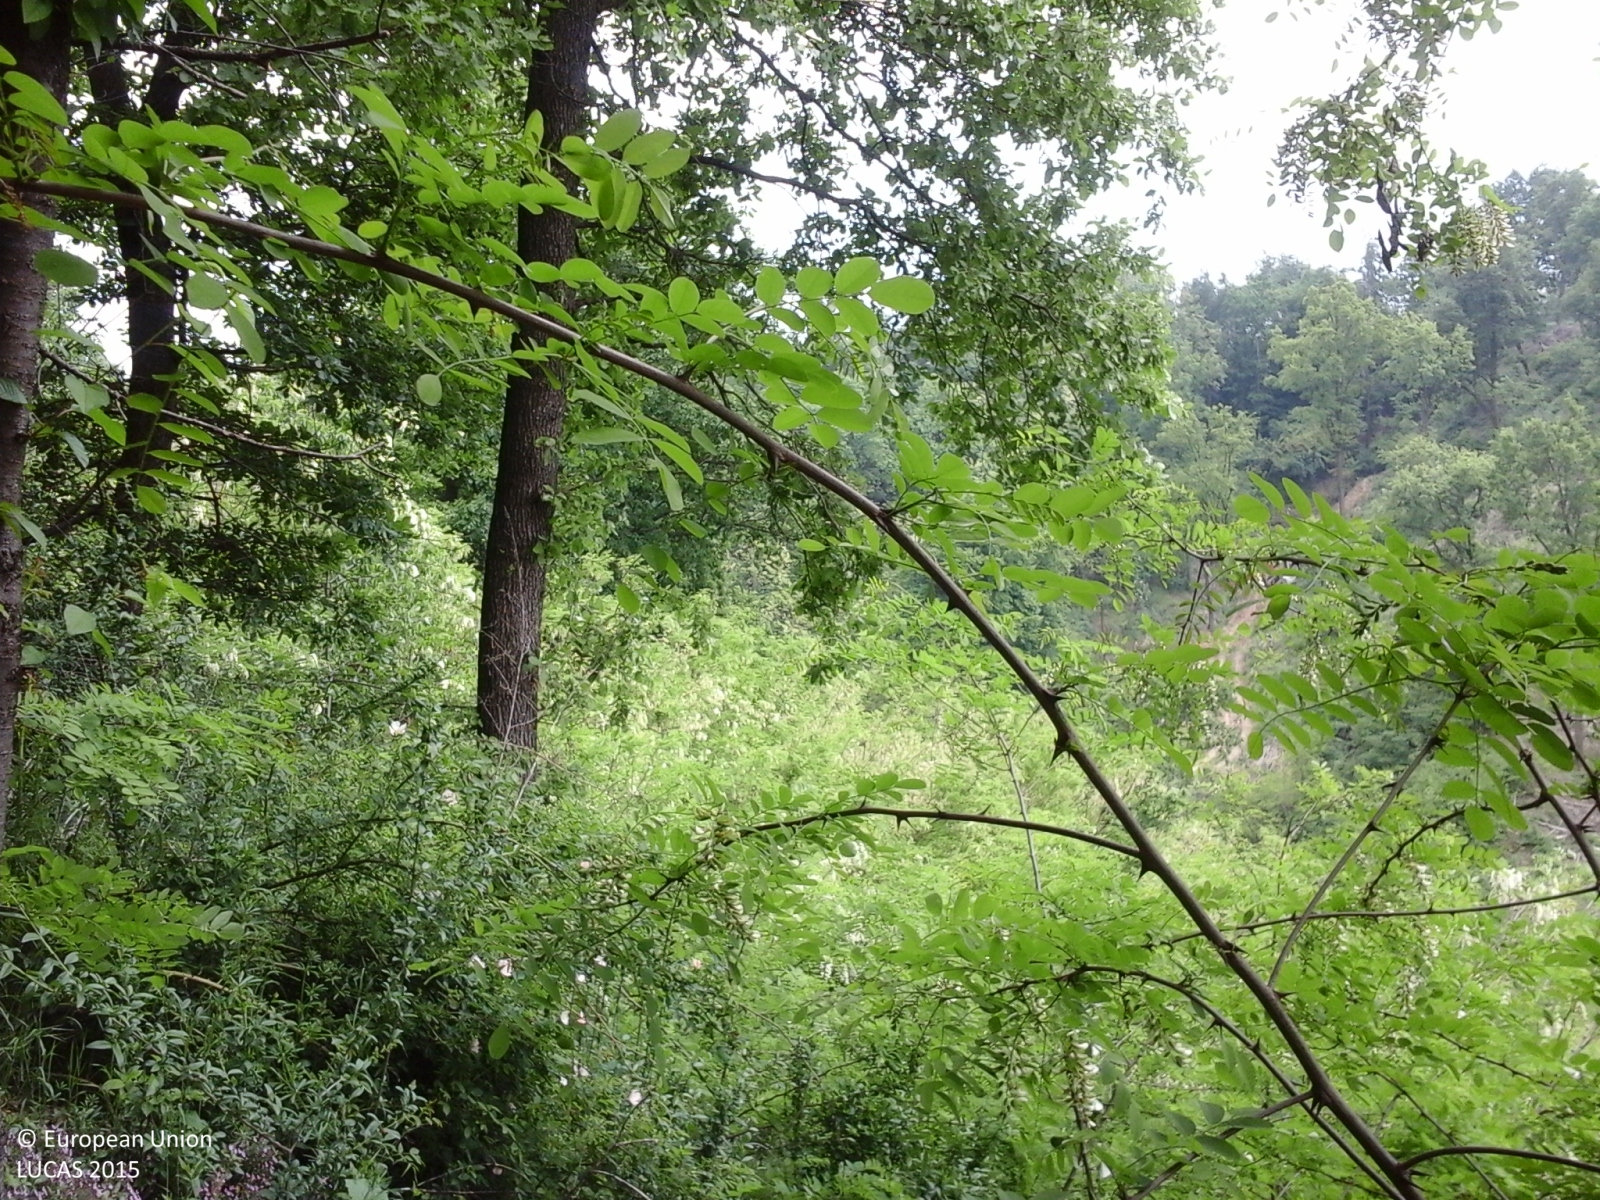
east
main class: Woodland
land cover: Broadleaved woodland
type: thermophilous deciduous forest
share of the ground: > 75 %
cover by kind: broadleaved forest trees 95 %, herbaceous plants 5 %
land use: Forestry
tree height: > 5 m
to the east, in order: Broadleaved woodland
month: May
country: IT
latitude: 44.5613
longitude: 7.7761
